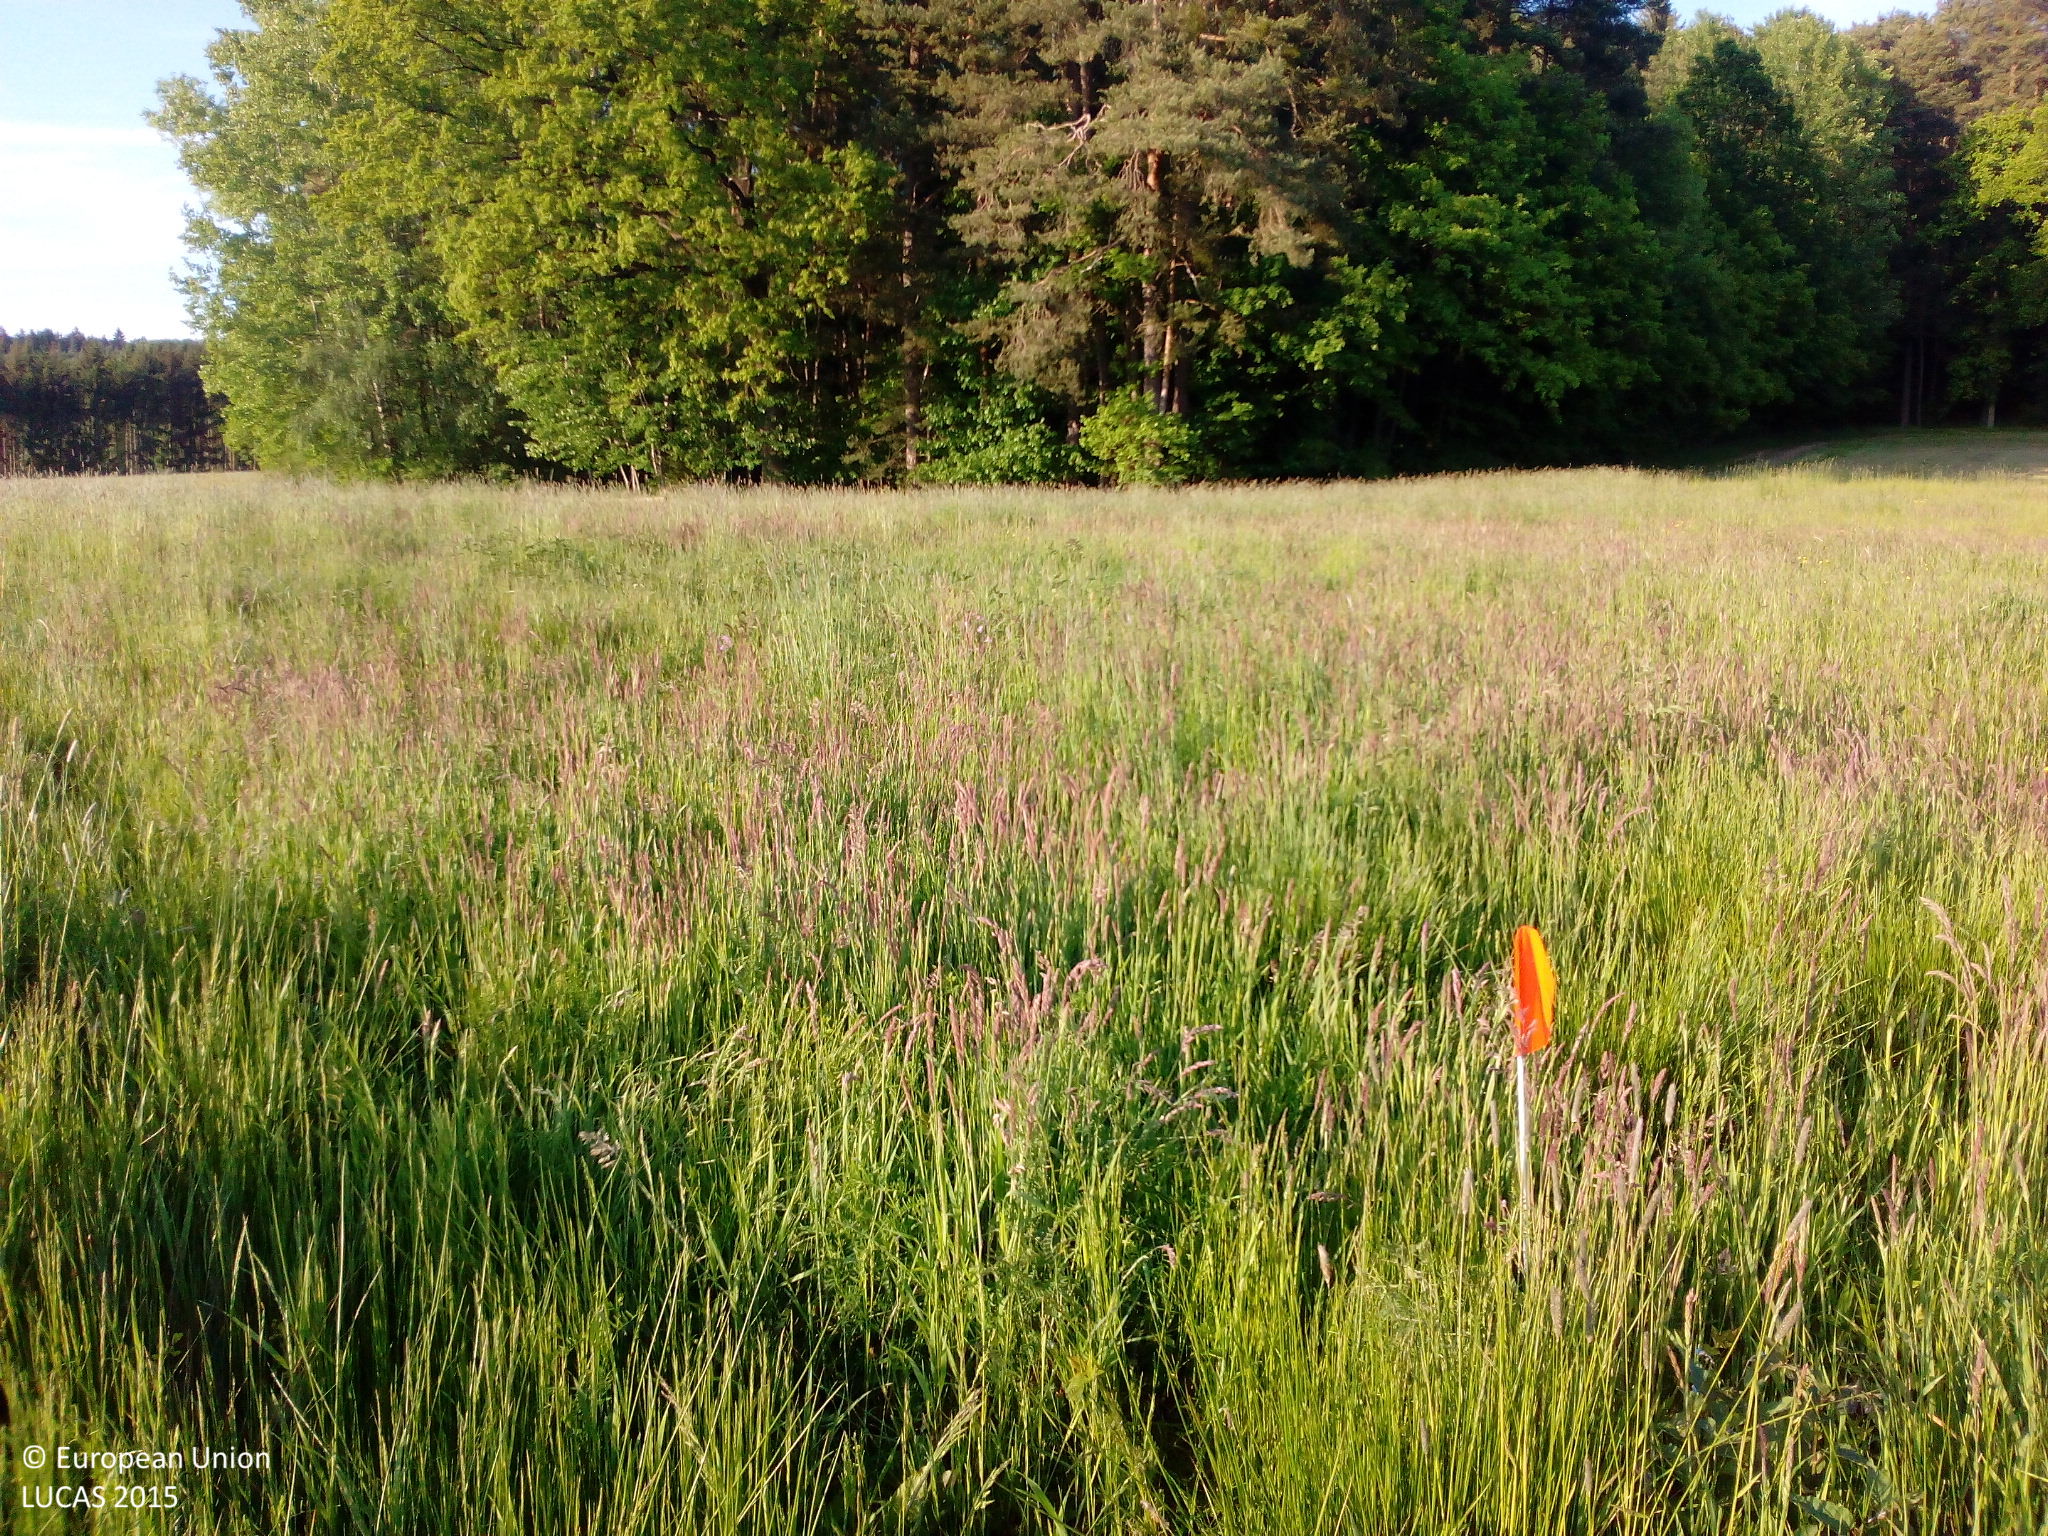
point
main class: Grassland
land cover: Grassland without tree/shrub cover
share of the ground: > 75 %
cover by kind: herbaceous plants 95 %, unconsolidated bare surface 5 %
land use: Agriculture (excluding fallow land and kitchen gardens)
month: May
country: DE
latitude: 49.2214
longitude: 11.4686
